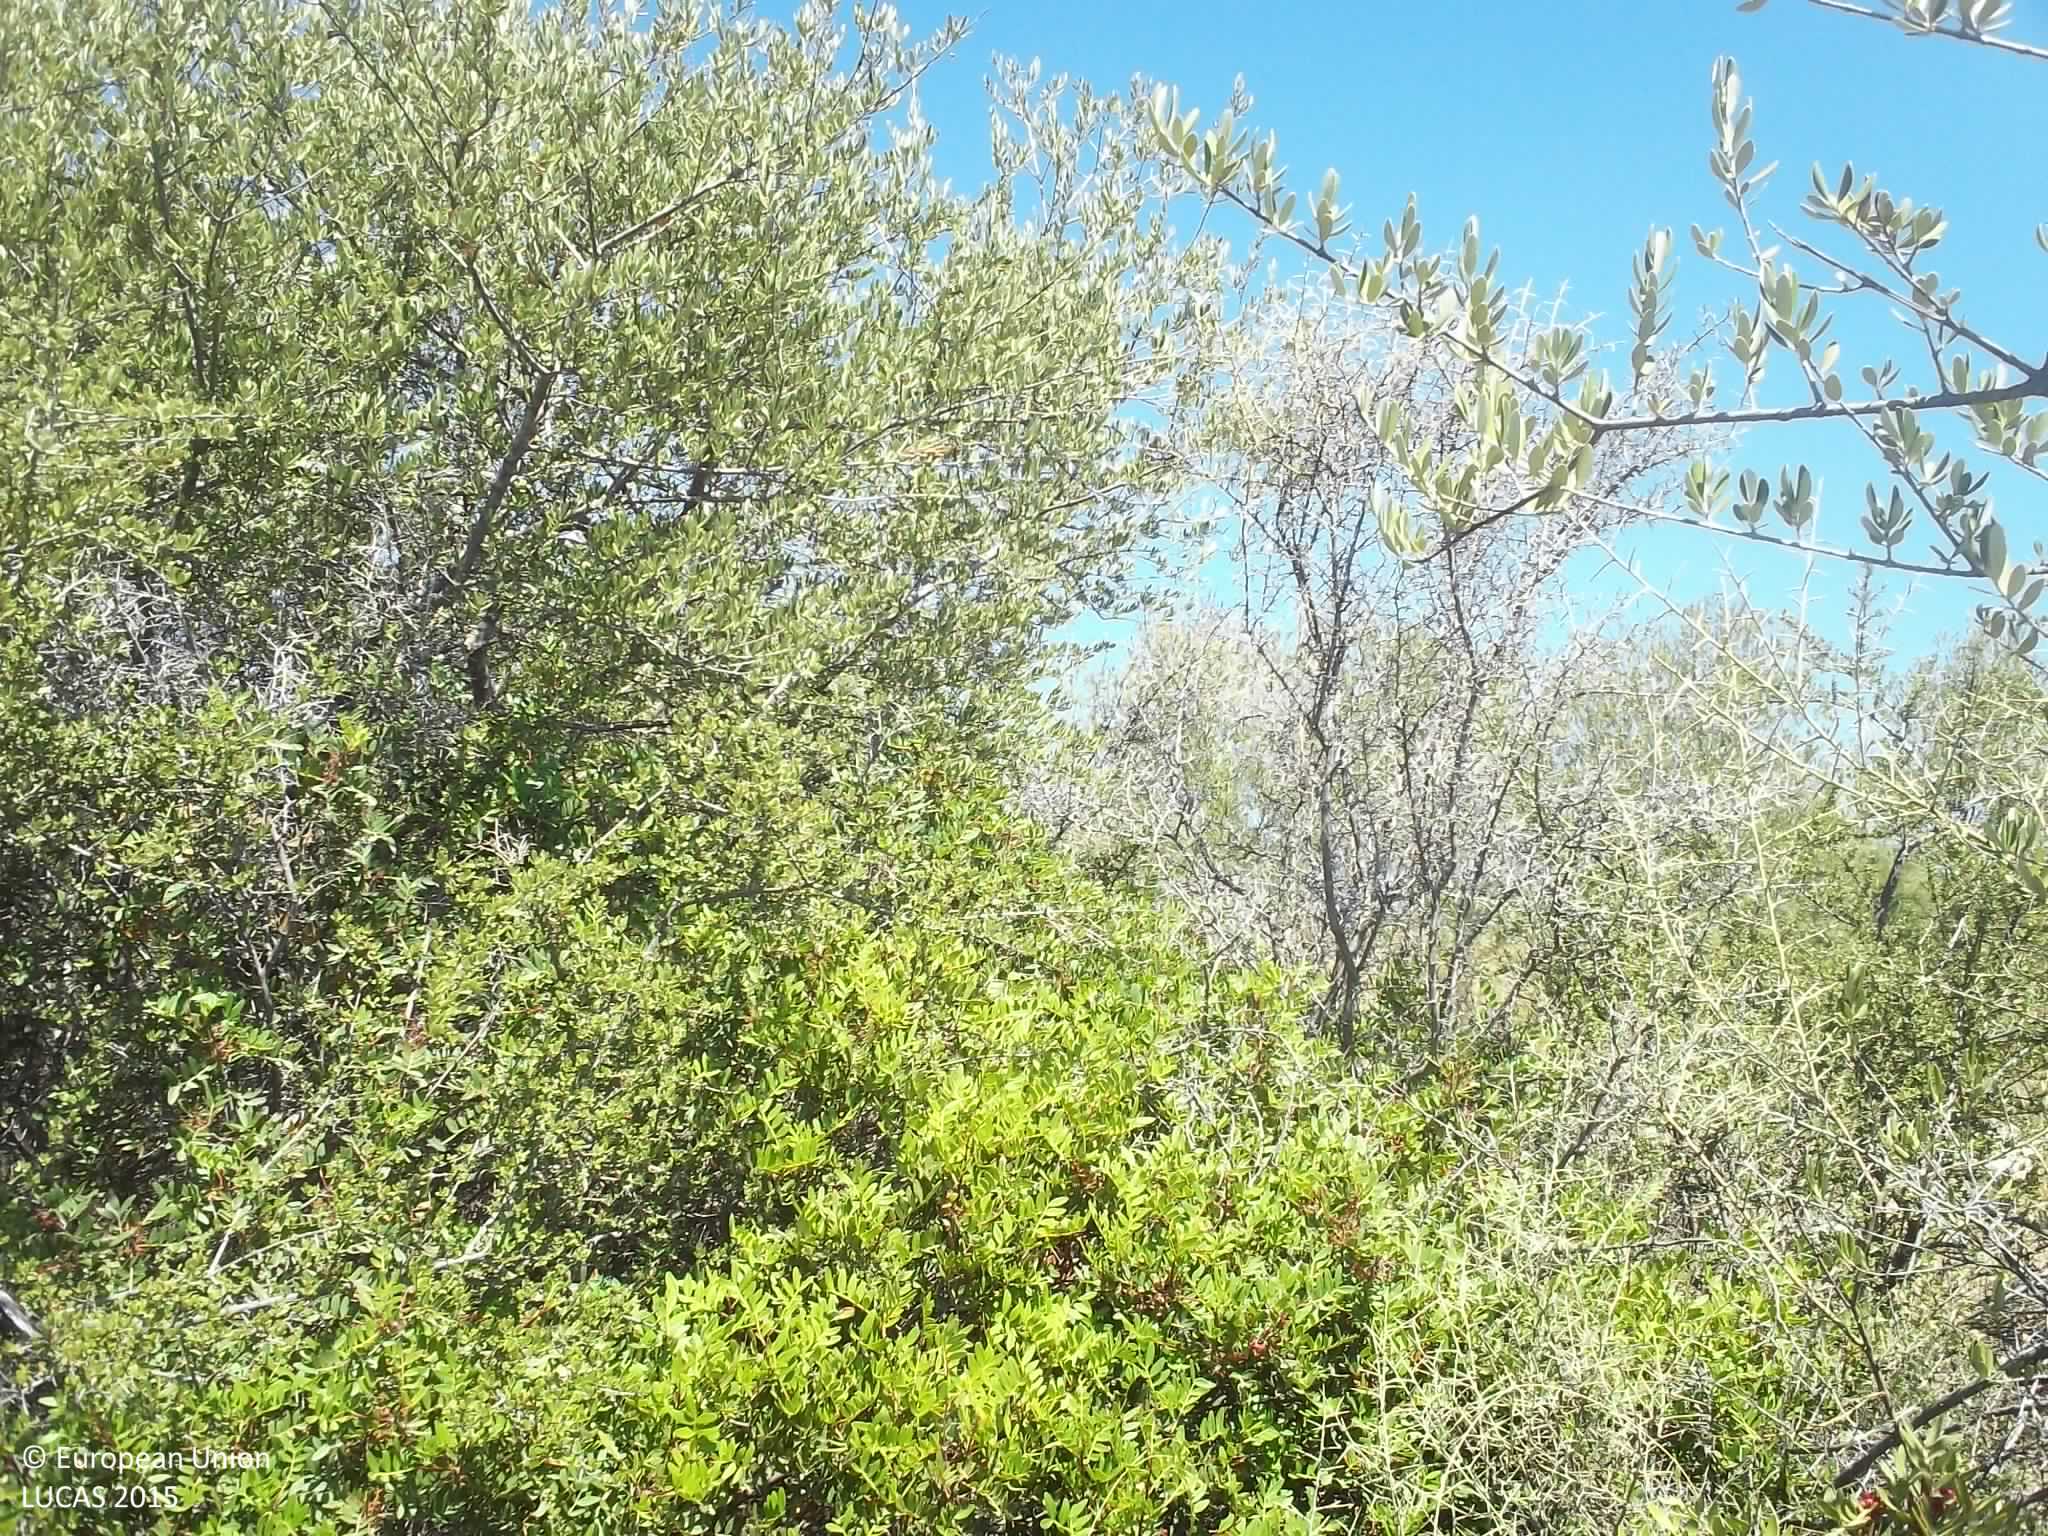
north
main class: Shrubland
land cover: Shrubland with sparse tree cover
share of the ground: 50 - 75 %
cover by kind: shrubs 55 %, herbaceous plants 20 %, consolidated bare surface 20 %, broadleaved forest trees 5 %
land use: Semi-natural and natural areas not in use
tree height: < 5 m
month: August
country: GR
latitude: 36.8308
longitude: 22.6121
